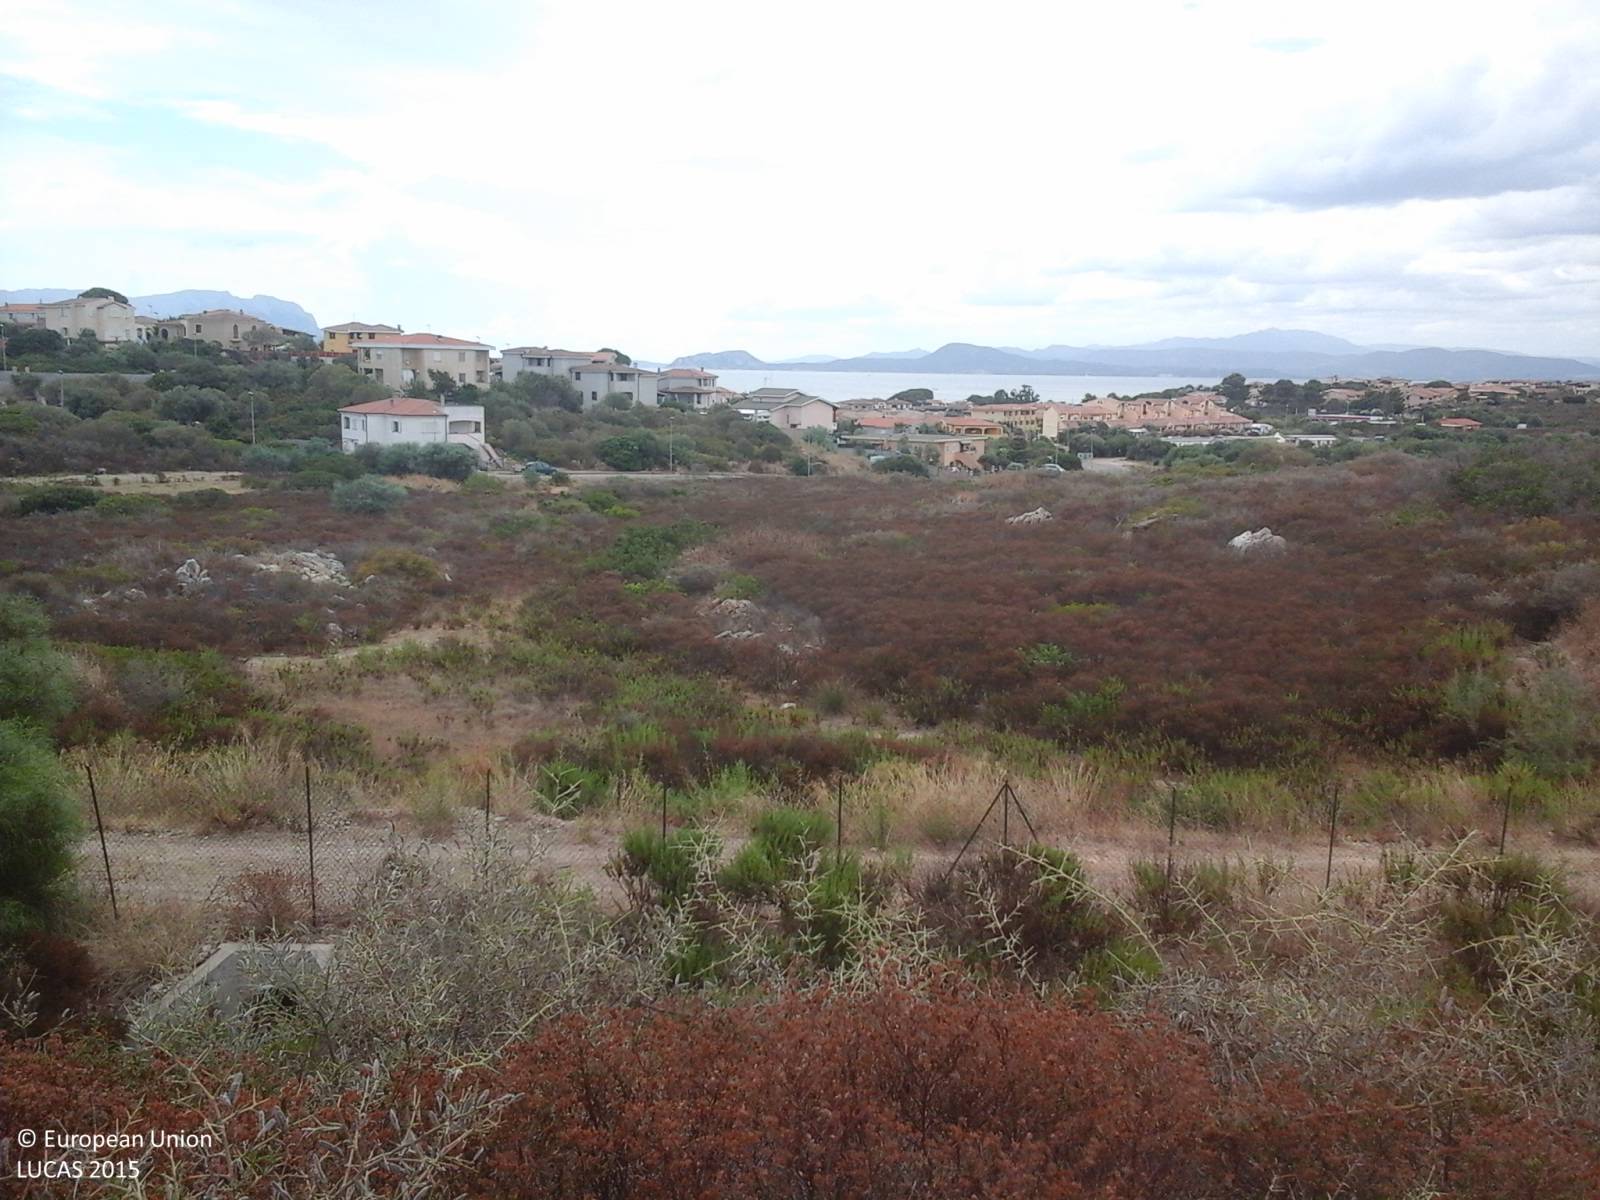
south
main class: Shrubland
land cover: Shrubland without tree cover
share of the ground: > 75 %
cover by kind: shrubs 95 %, unconsolidated bare surface 5 %
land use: Abandoned areas
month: August
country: IT
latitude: 41.0085
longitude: 9.6094
